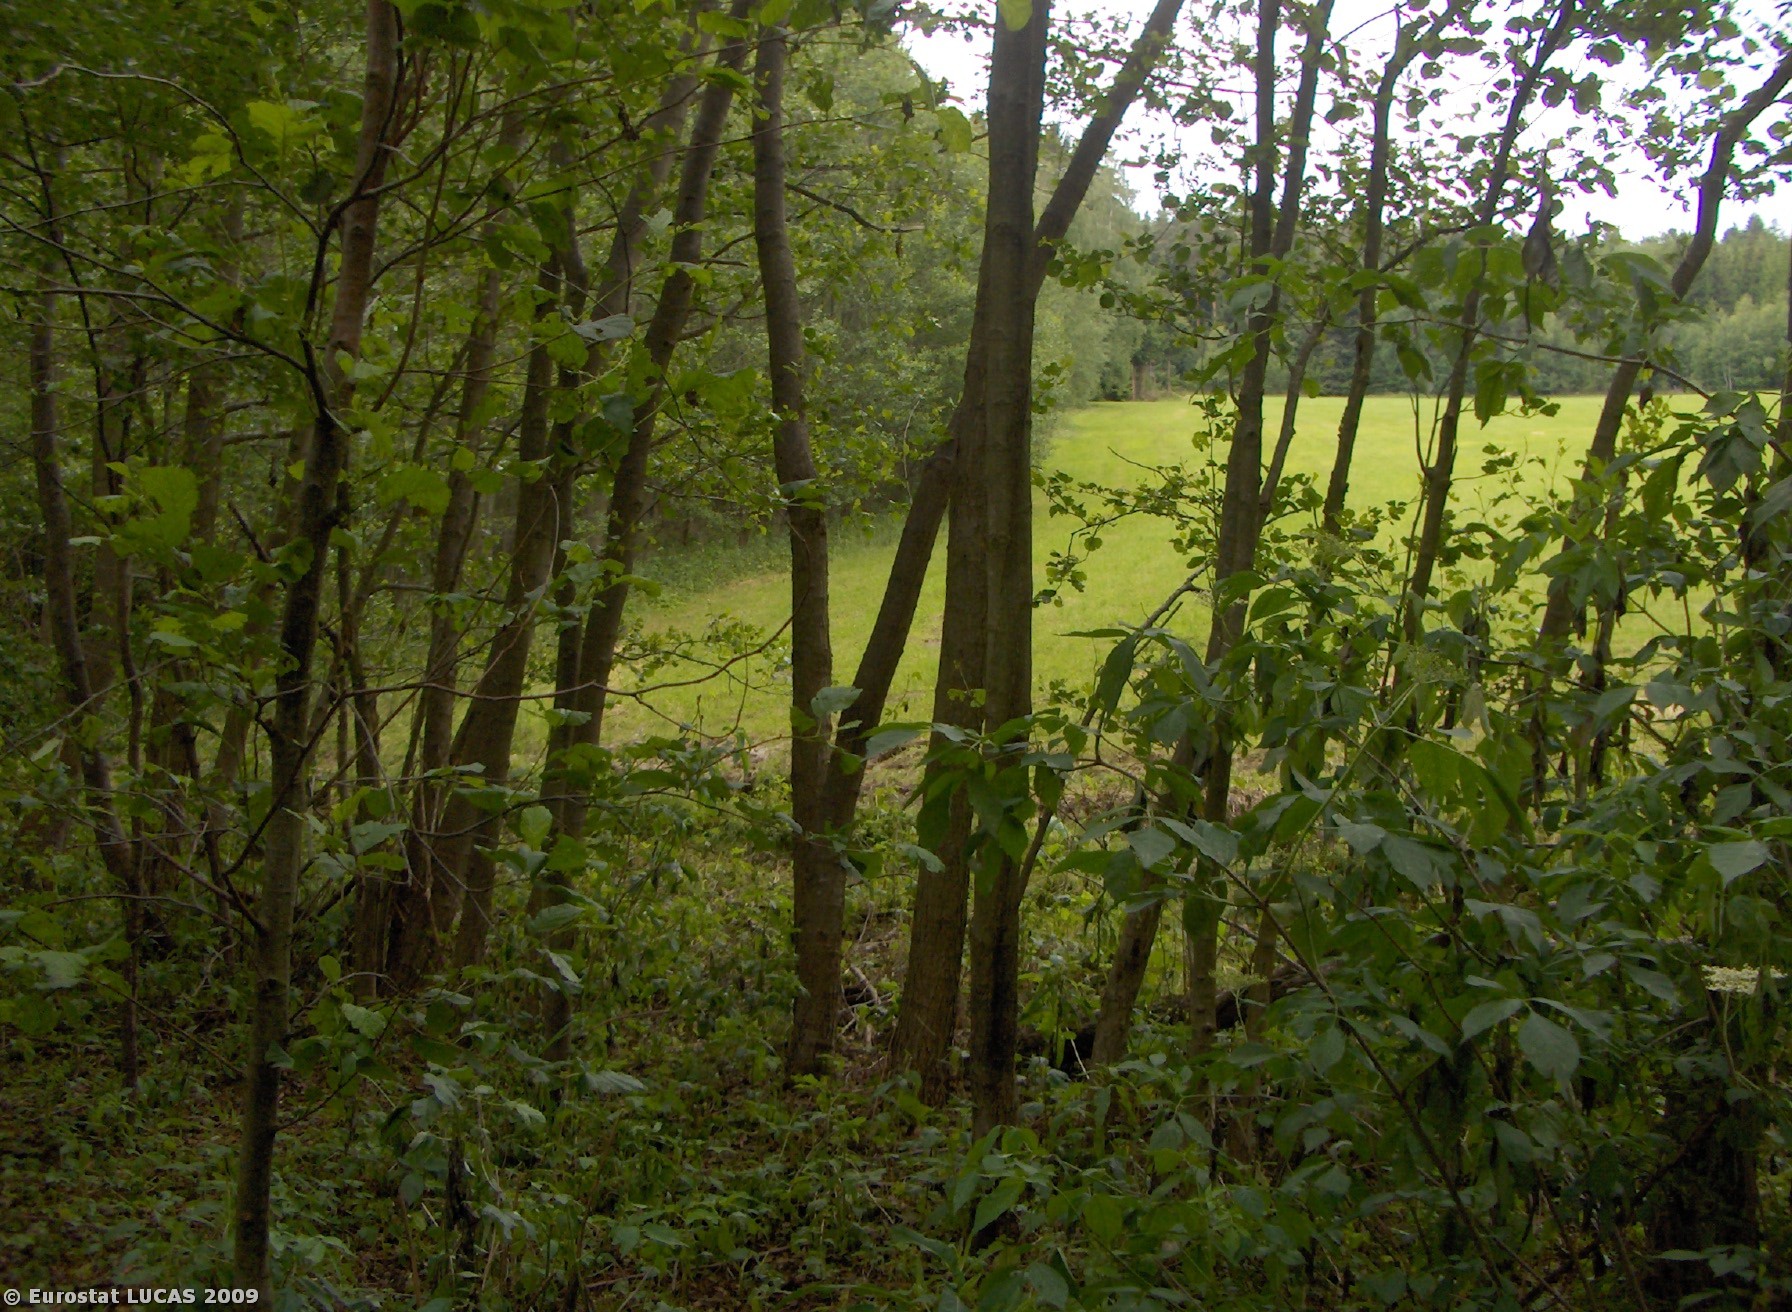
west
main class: Woodland
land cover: Broadleaved woodland
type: non-riverine alder, birch or aspen forest
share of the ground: > 75 %
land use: Forestry
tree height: > 5 m
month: June
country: CZ
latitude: 48.9755
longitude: 14.1128
